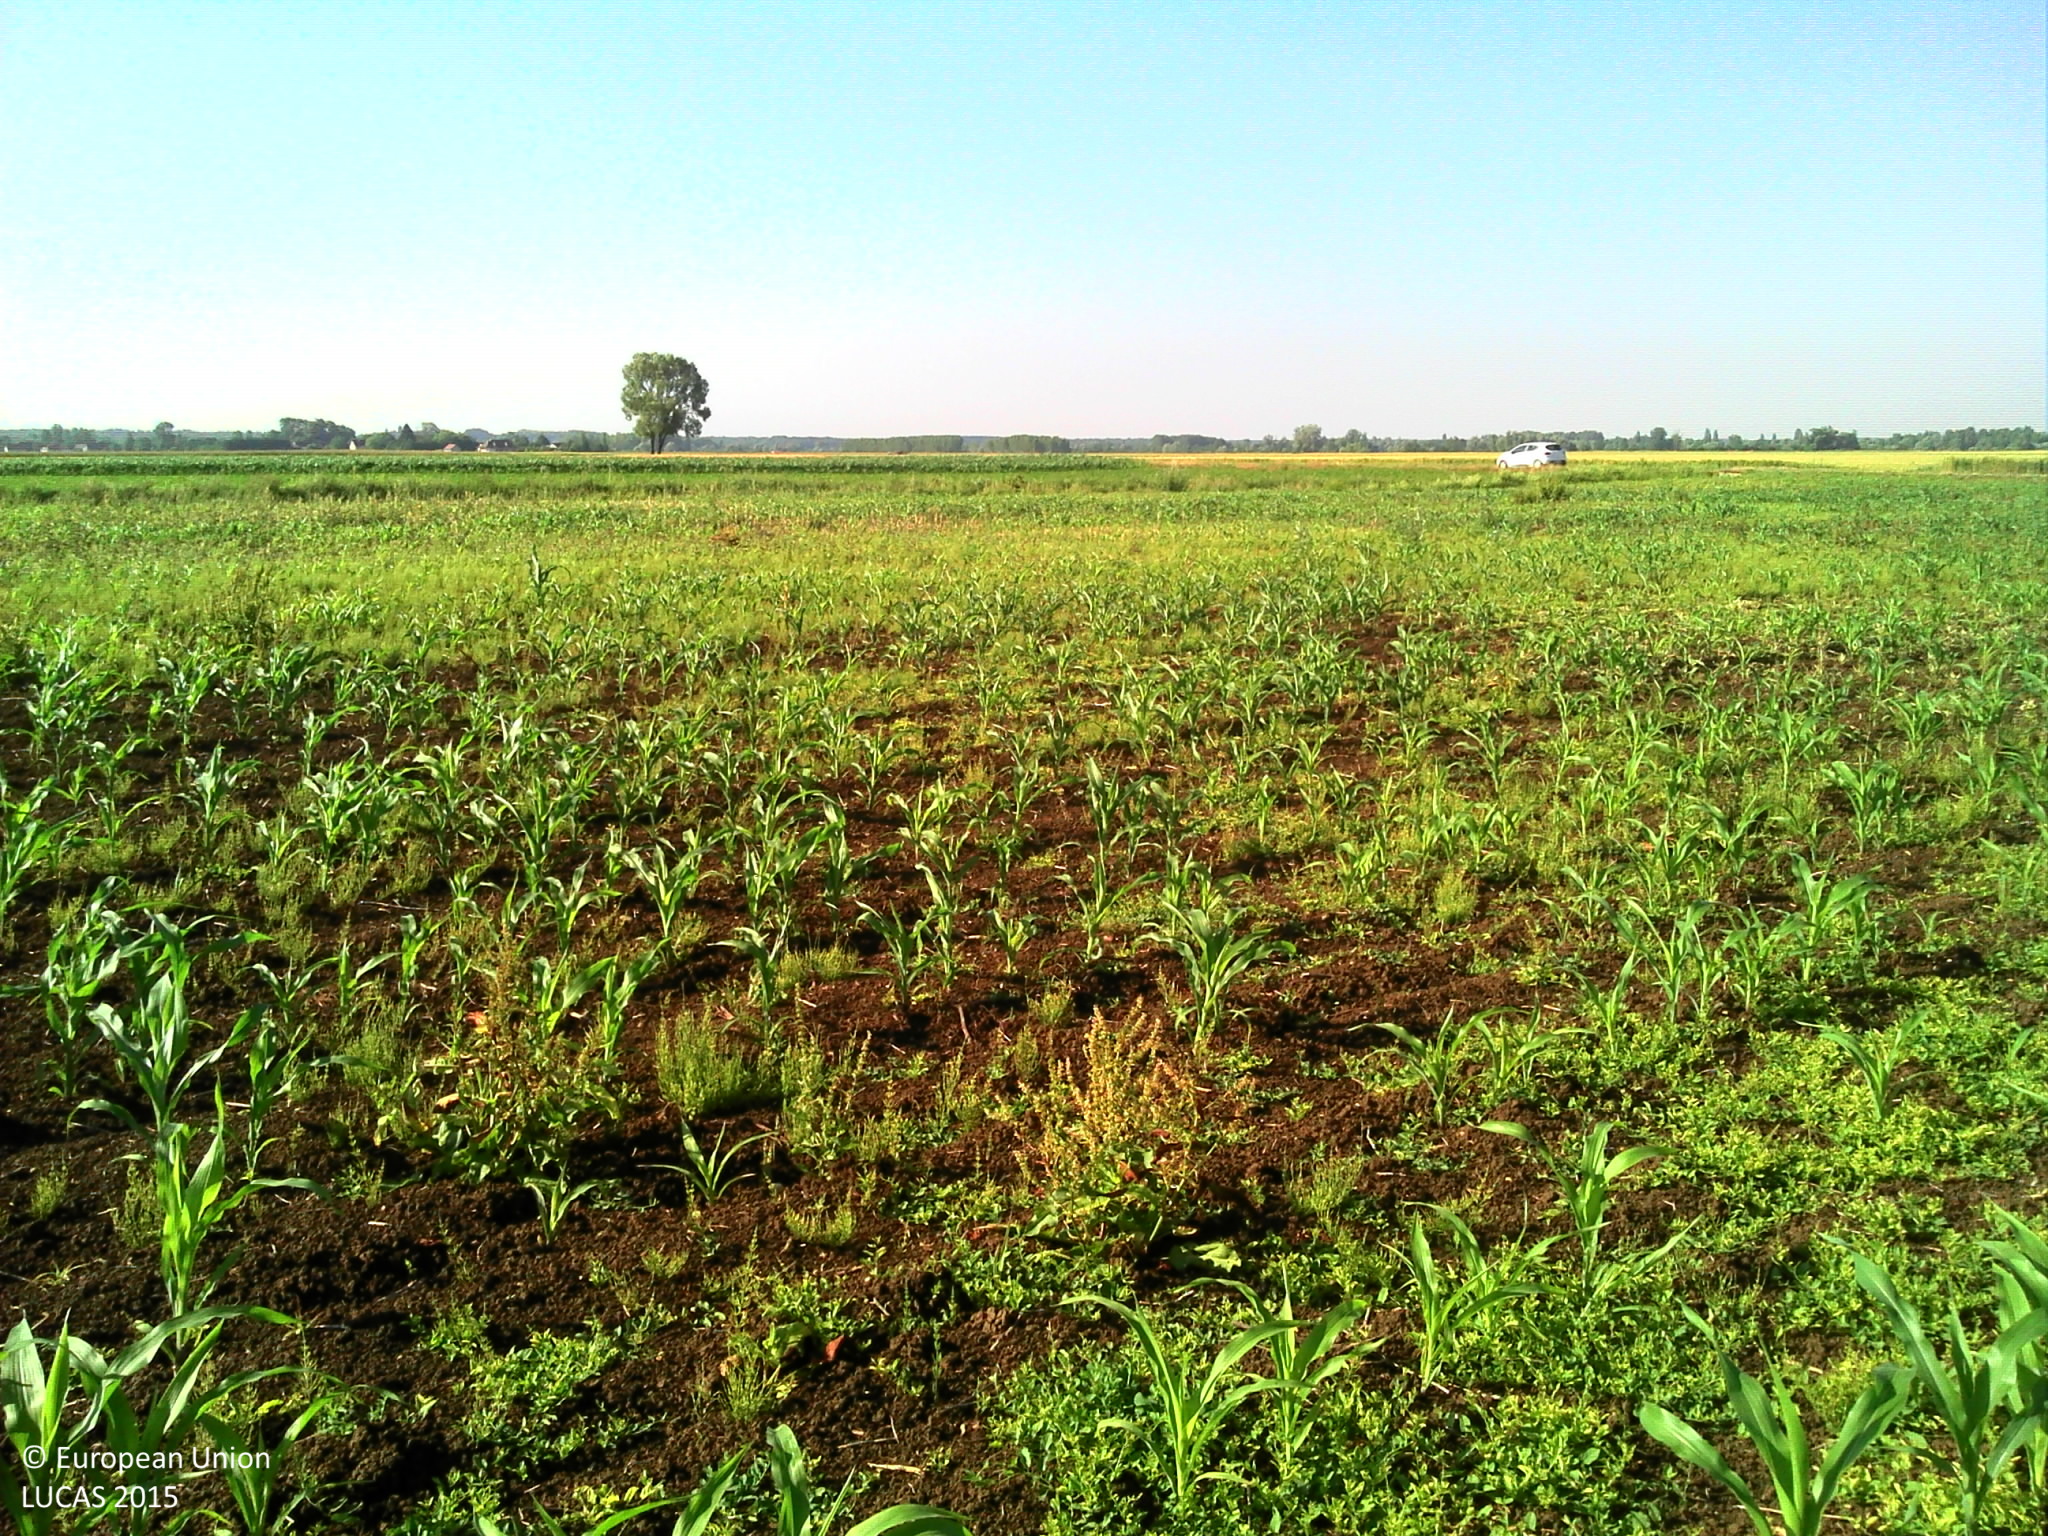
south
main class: Cropland
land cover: Maize
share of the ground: 25 - 50 %
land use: Agriculture (excluding fallow land and kitchen gardens)
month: June
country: FR
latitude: 46.9519
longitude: 5.3108
